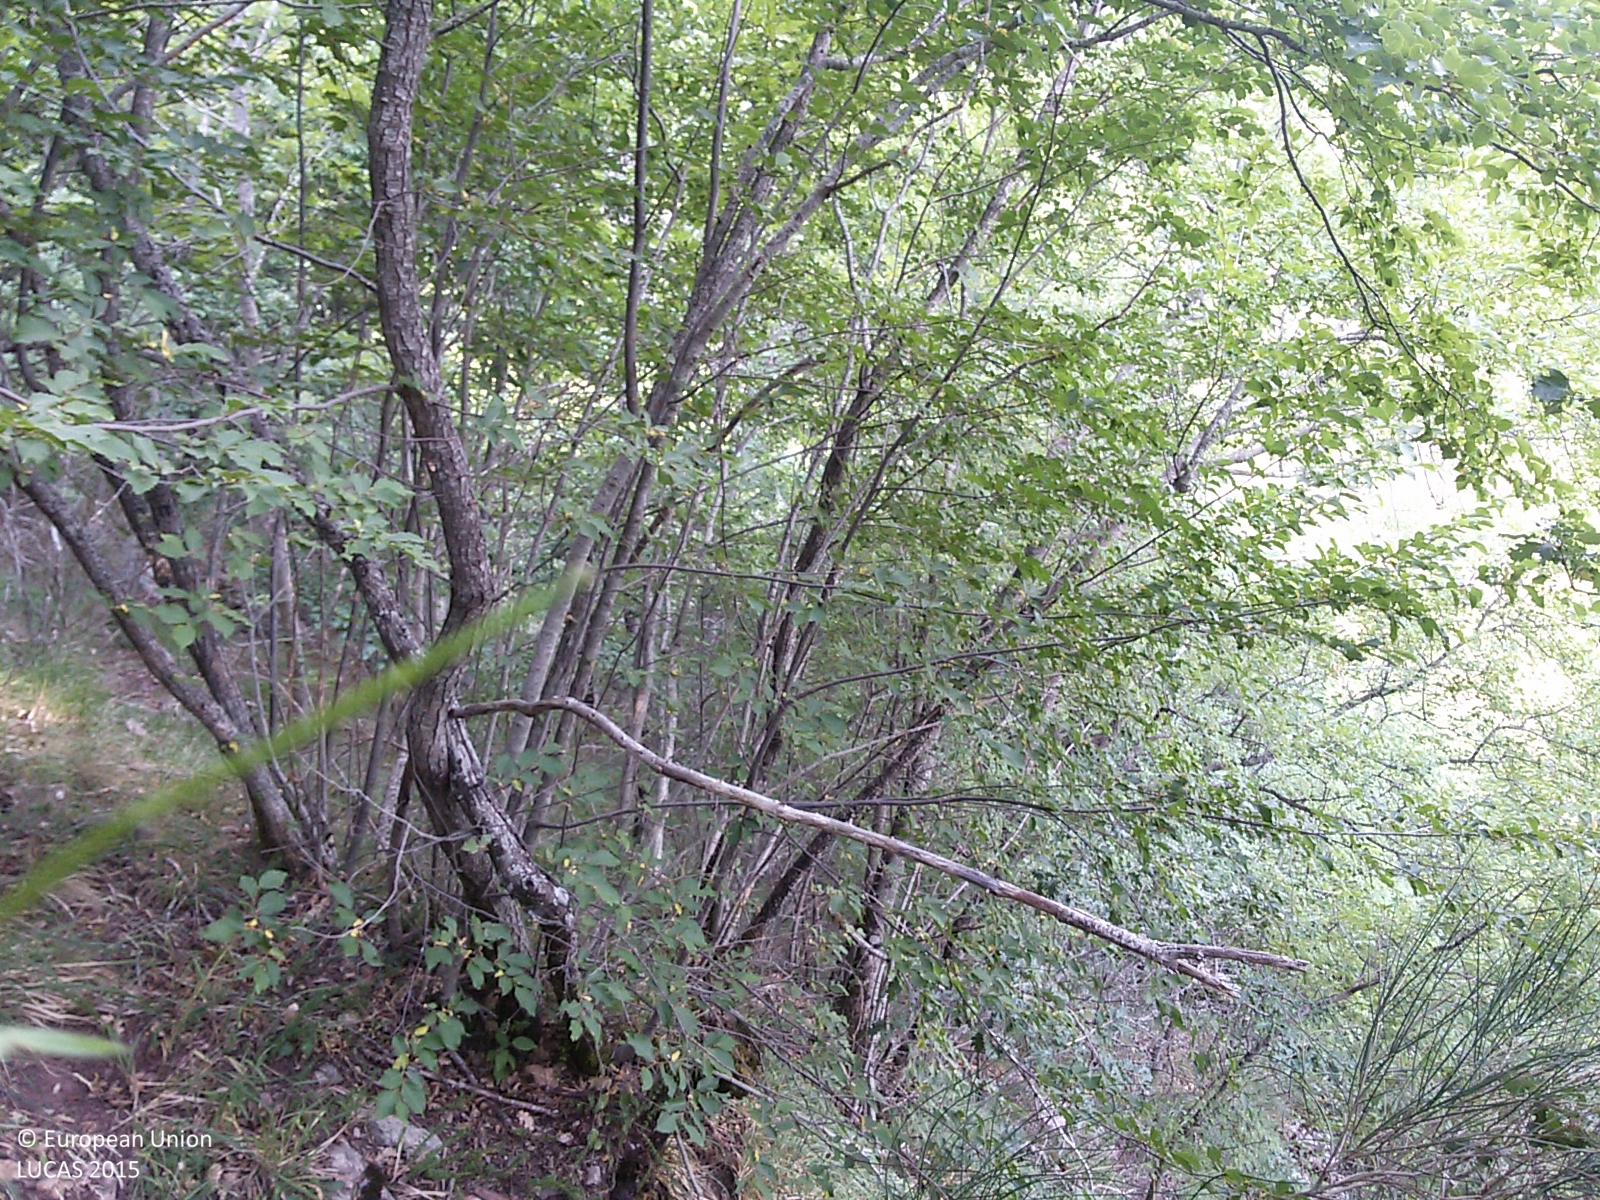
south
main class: Woodland
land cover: Broadleaved woodland
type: thermophilous deciduous forest
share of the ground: 50 - 75 %
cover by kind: broadleaved forest trees 55 %, shrubs 20 %, consolidated bare surface 15 %, herbaceous plants 10 %
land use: Semi-natural and natural areas not in use
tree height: < 5 m
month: July
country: IT
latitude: 42.8420
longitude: 11.4758
